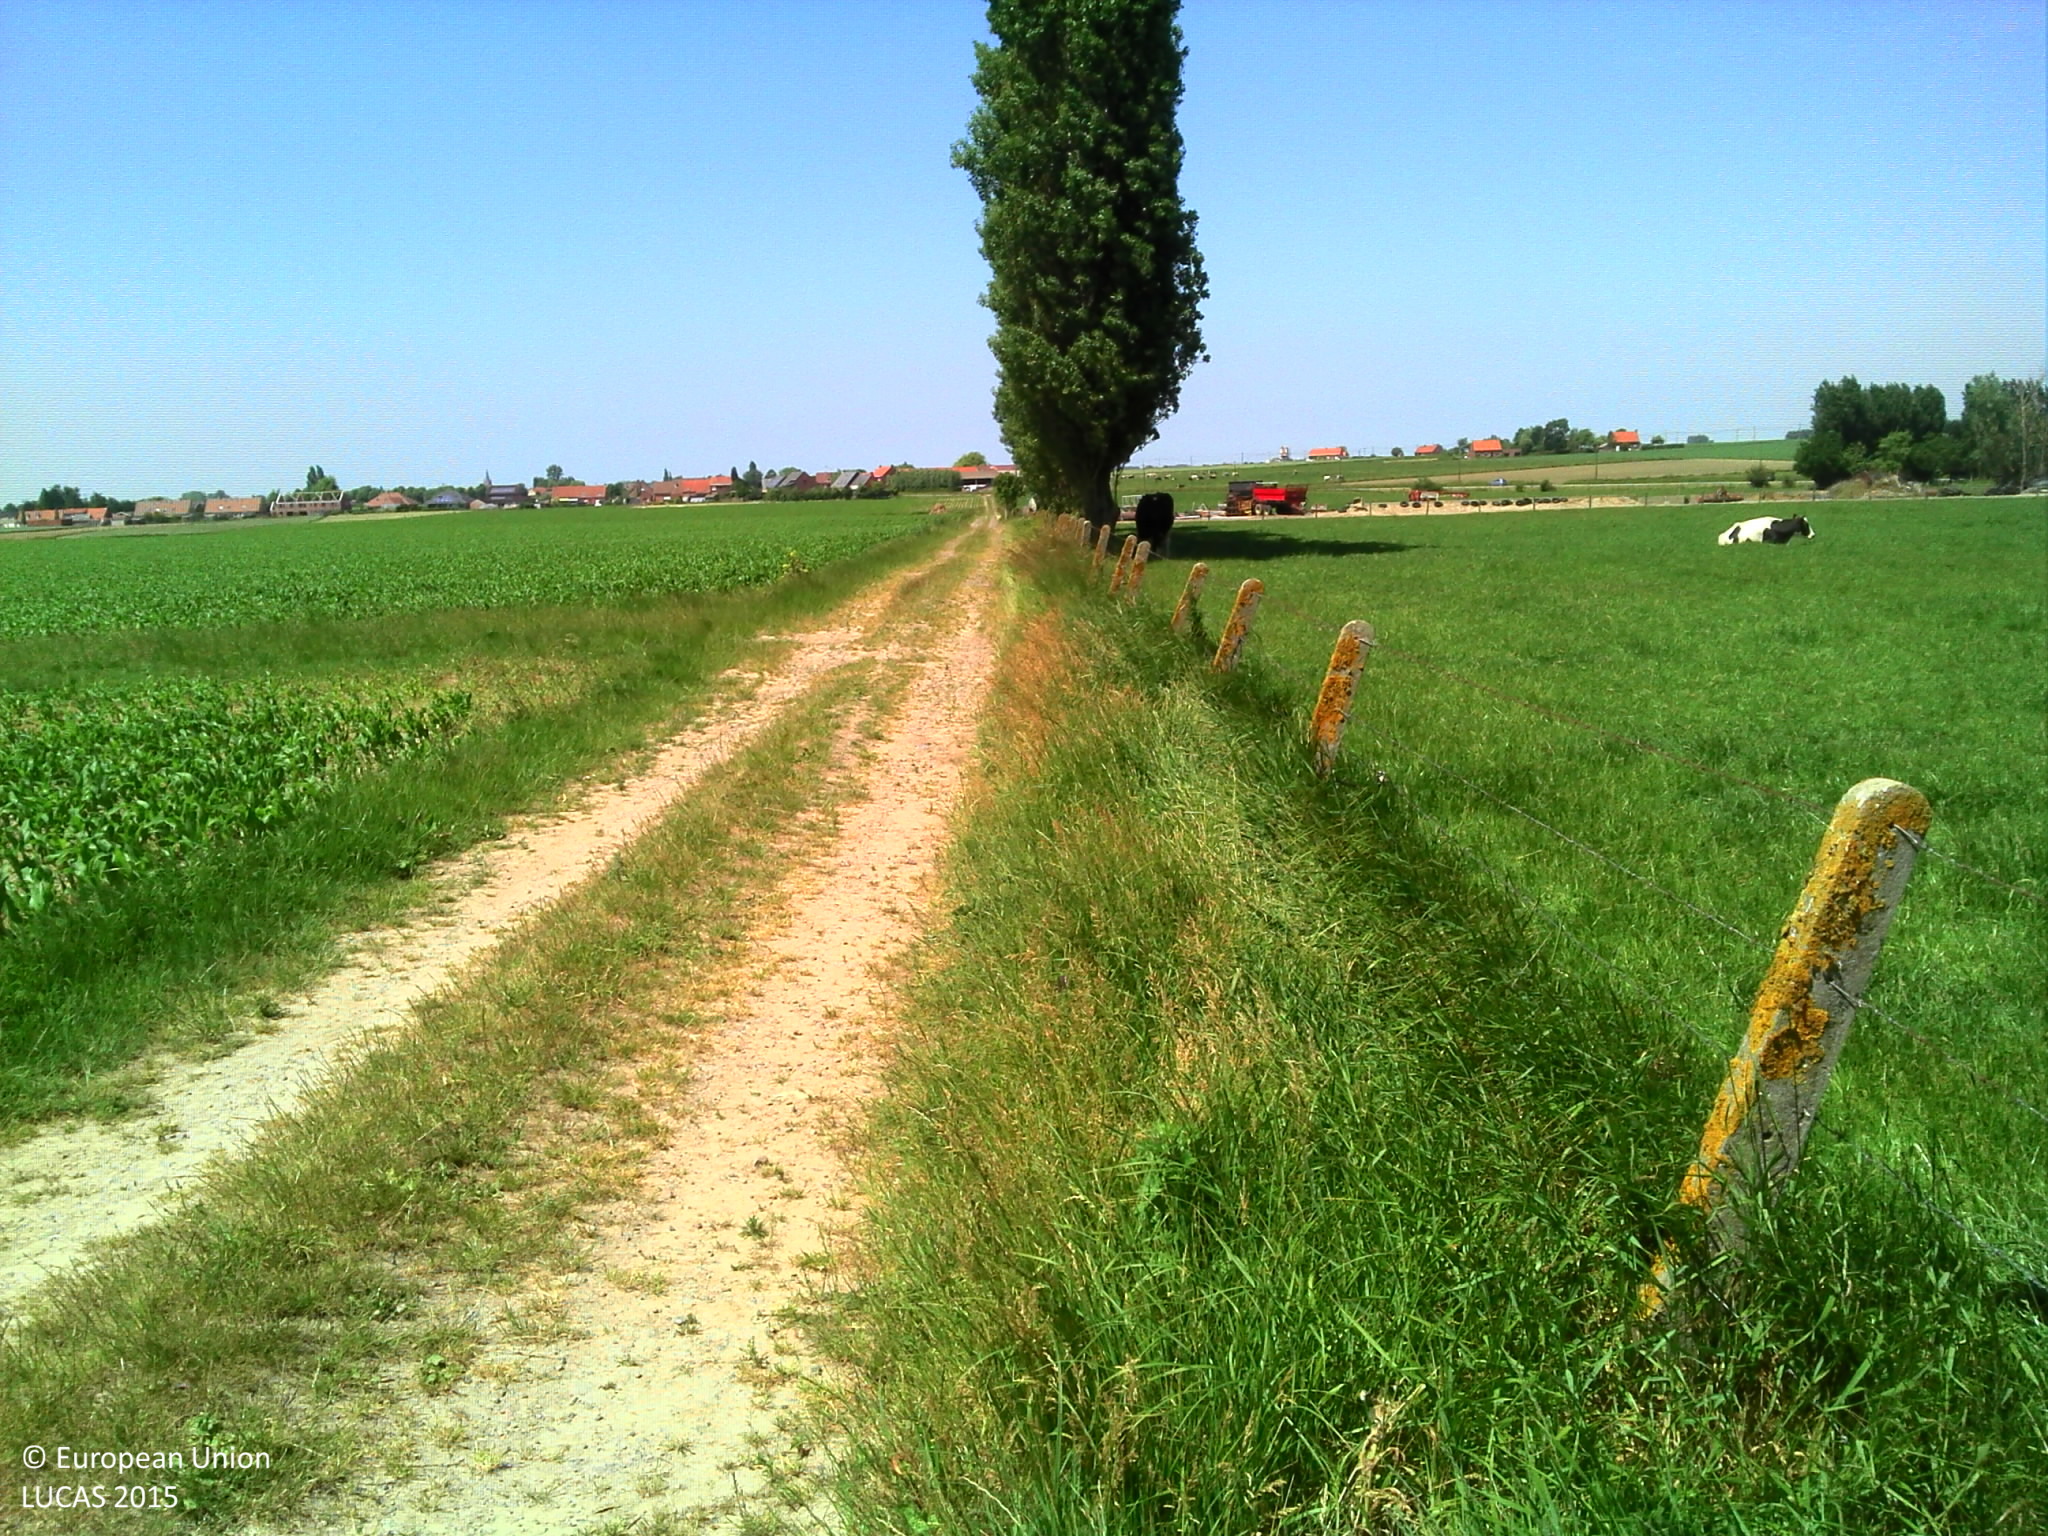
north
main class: Grassland
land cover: Grassland without tree/shrub cover
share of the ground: > 75 %
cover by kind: herbaceous plants 100 %
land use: Agriculture (excluding fallow land and kitchen gardens)
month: June
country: BE
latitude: 50.8867
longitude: 2.9532
